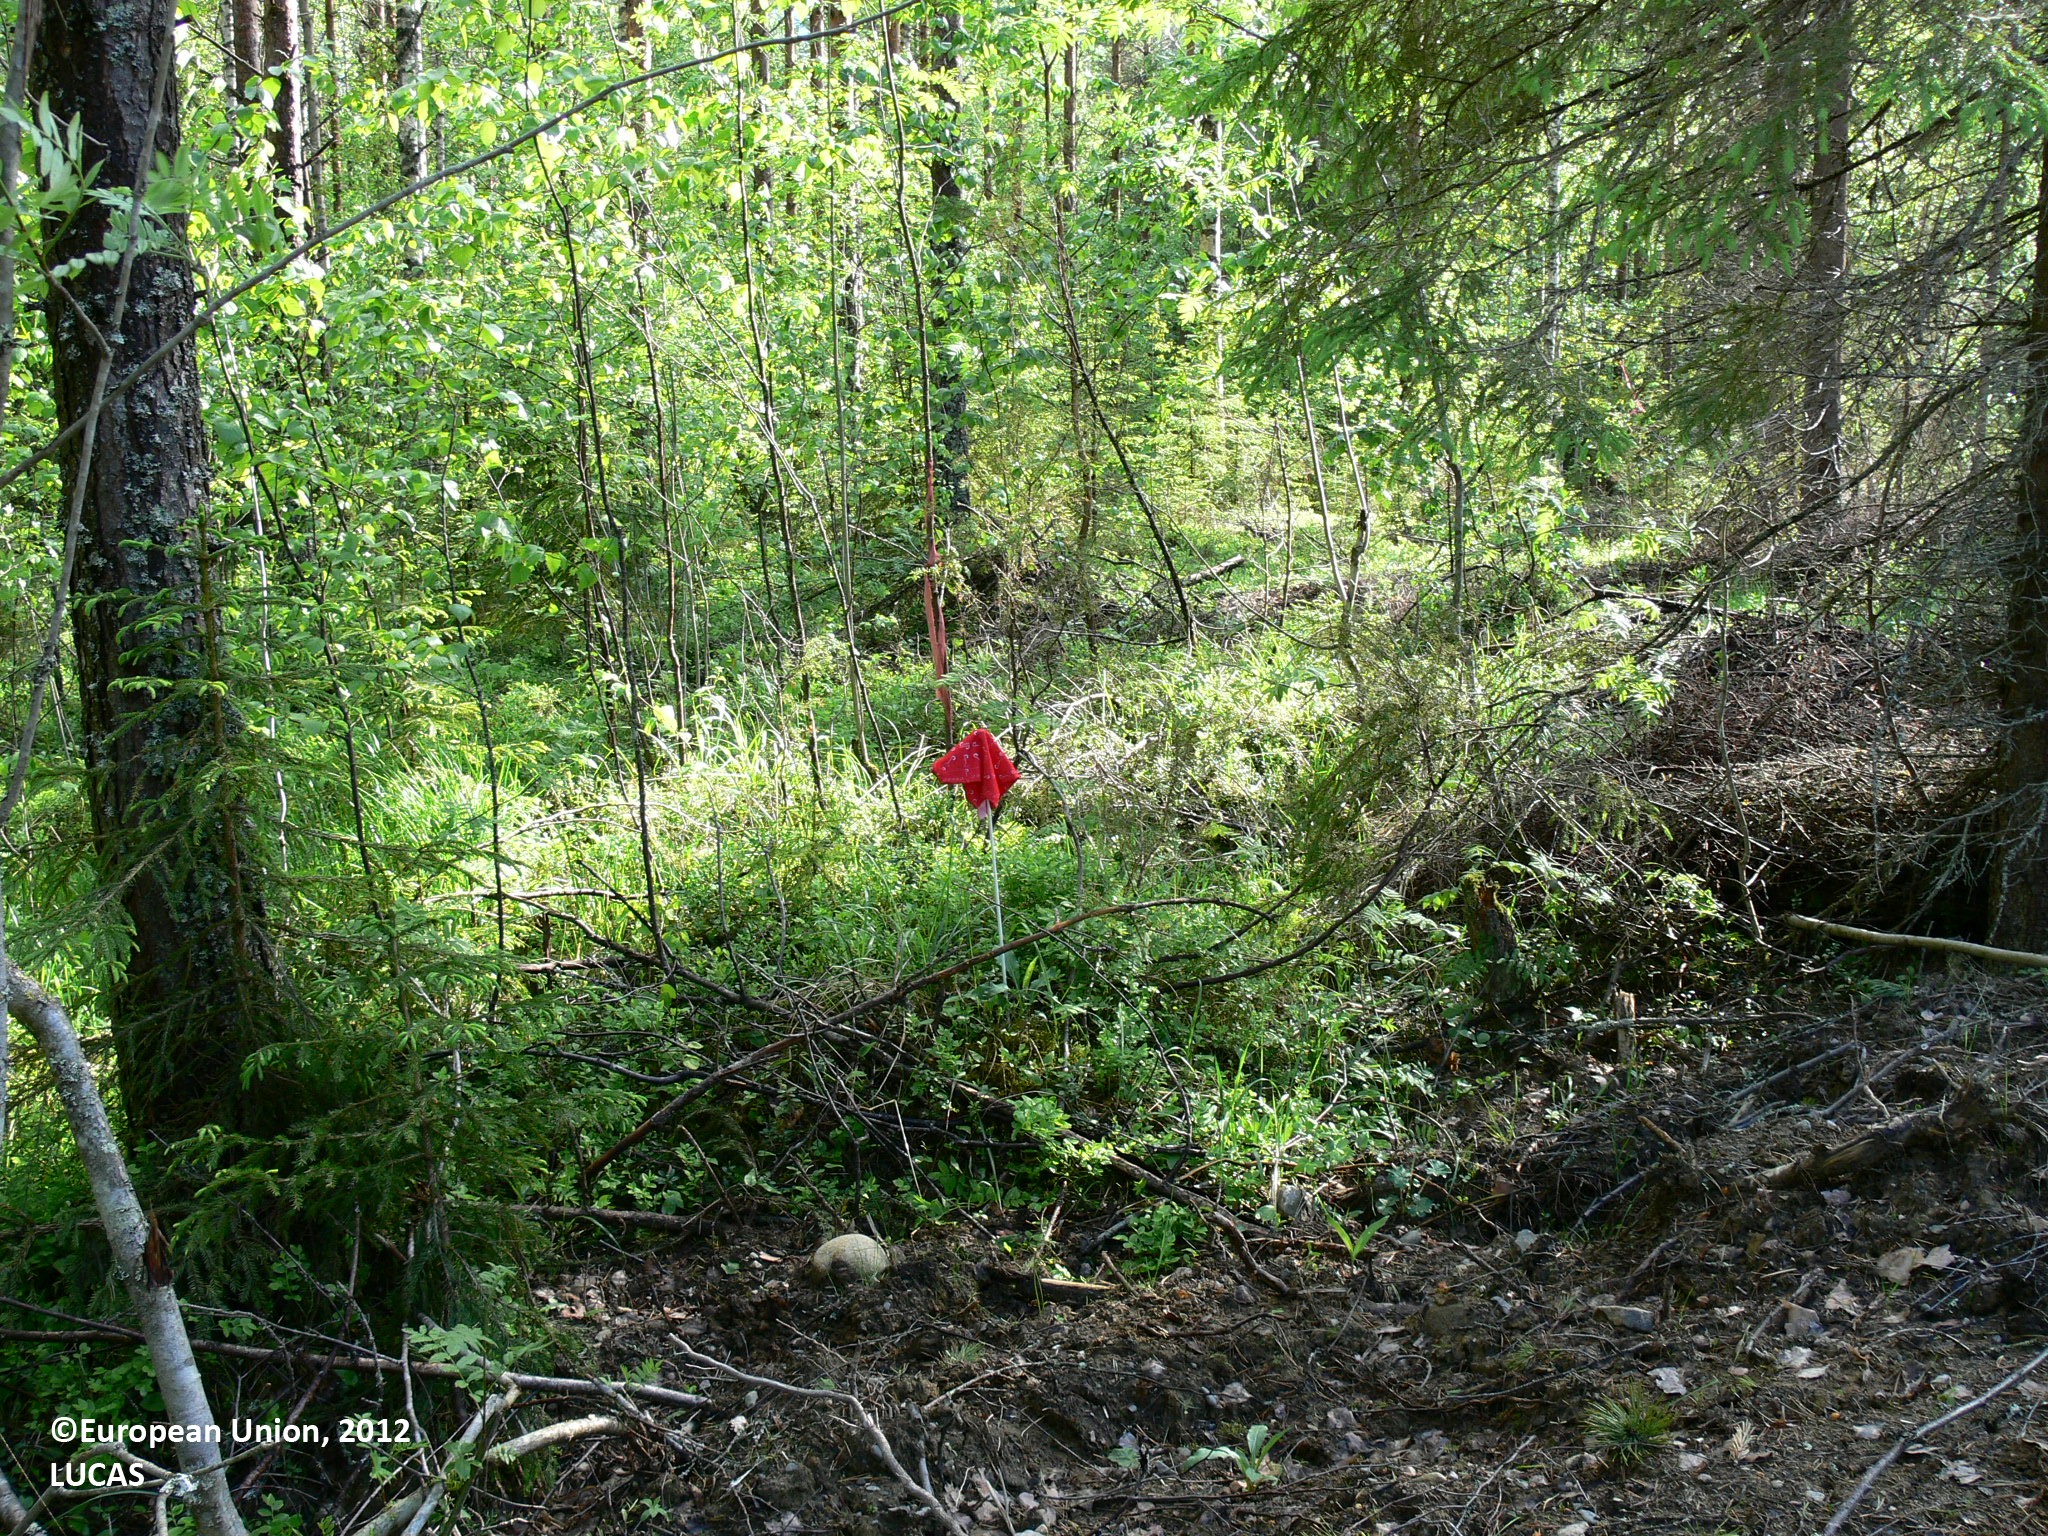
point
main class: Woodland
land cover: Pine dominated mixed woodland
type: boreal forest
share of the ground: > 75 %
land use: Forestry
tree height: > 5 m
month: June
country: FI
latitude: 62.4599
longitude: 30.3003
